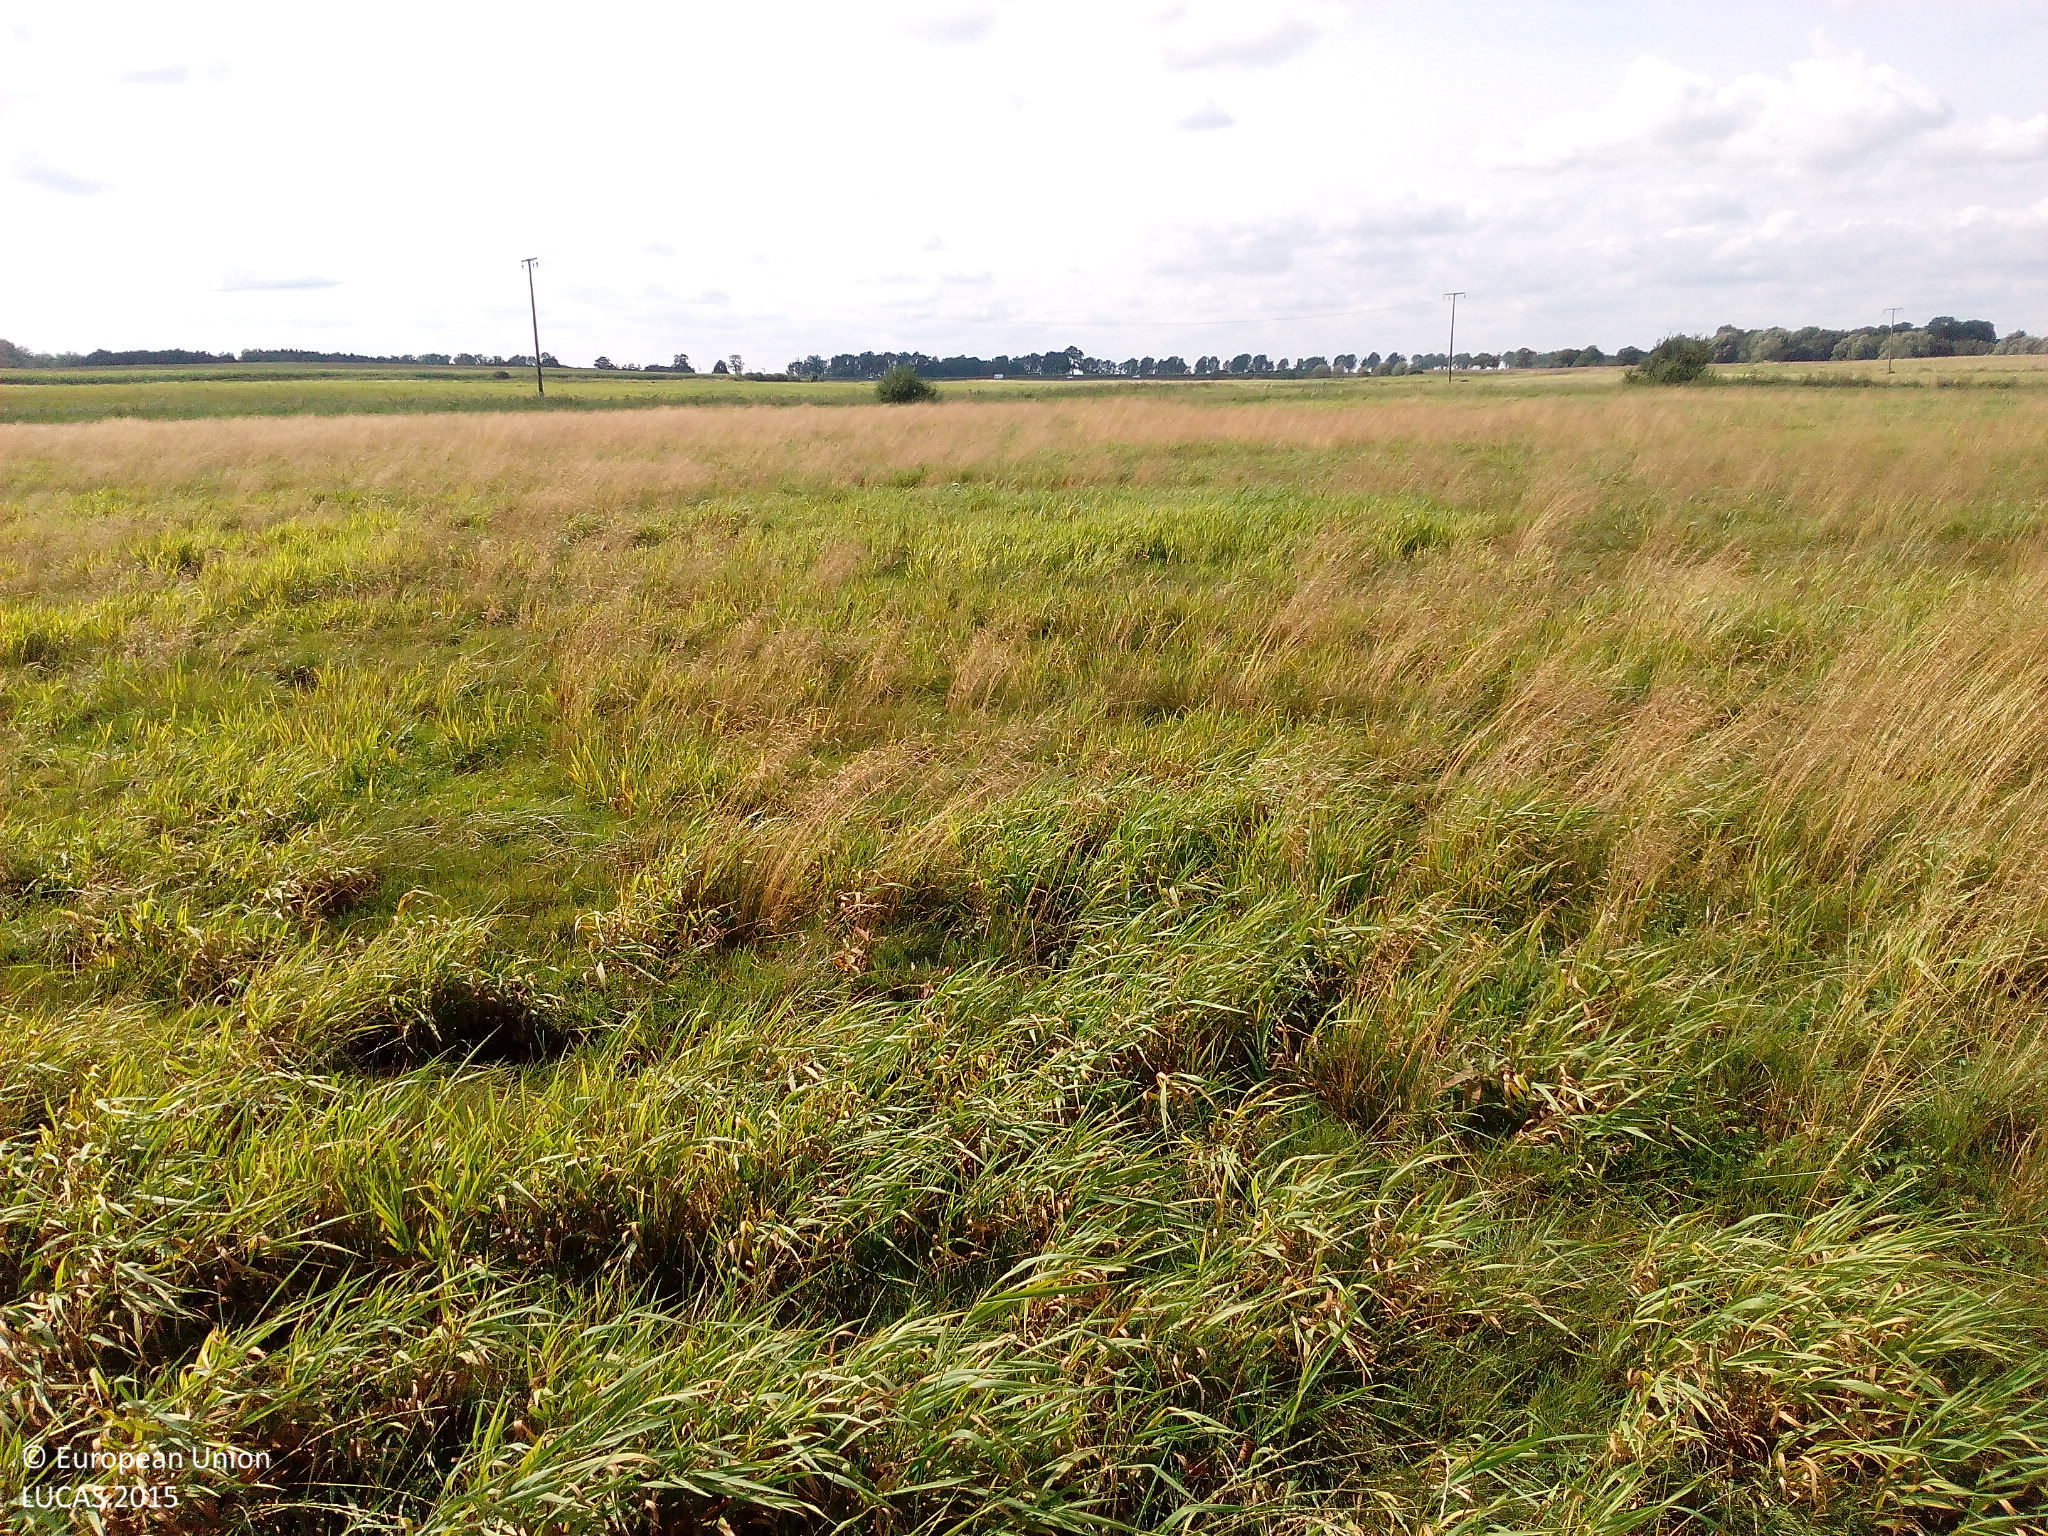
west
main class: Grassland
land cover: Grassland without tree/shrub cover
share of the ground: > 75 %
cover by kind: herbaceous plants 100 %
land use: Agriculture (excluding fallow land and kitchen gardens)
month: August
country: DE
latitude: 53.9295
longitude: 12.6949
